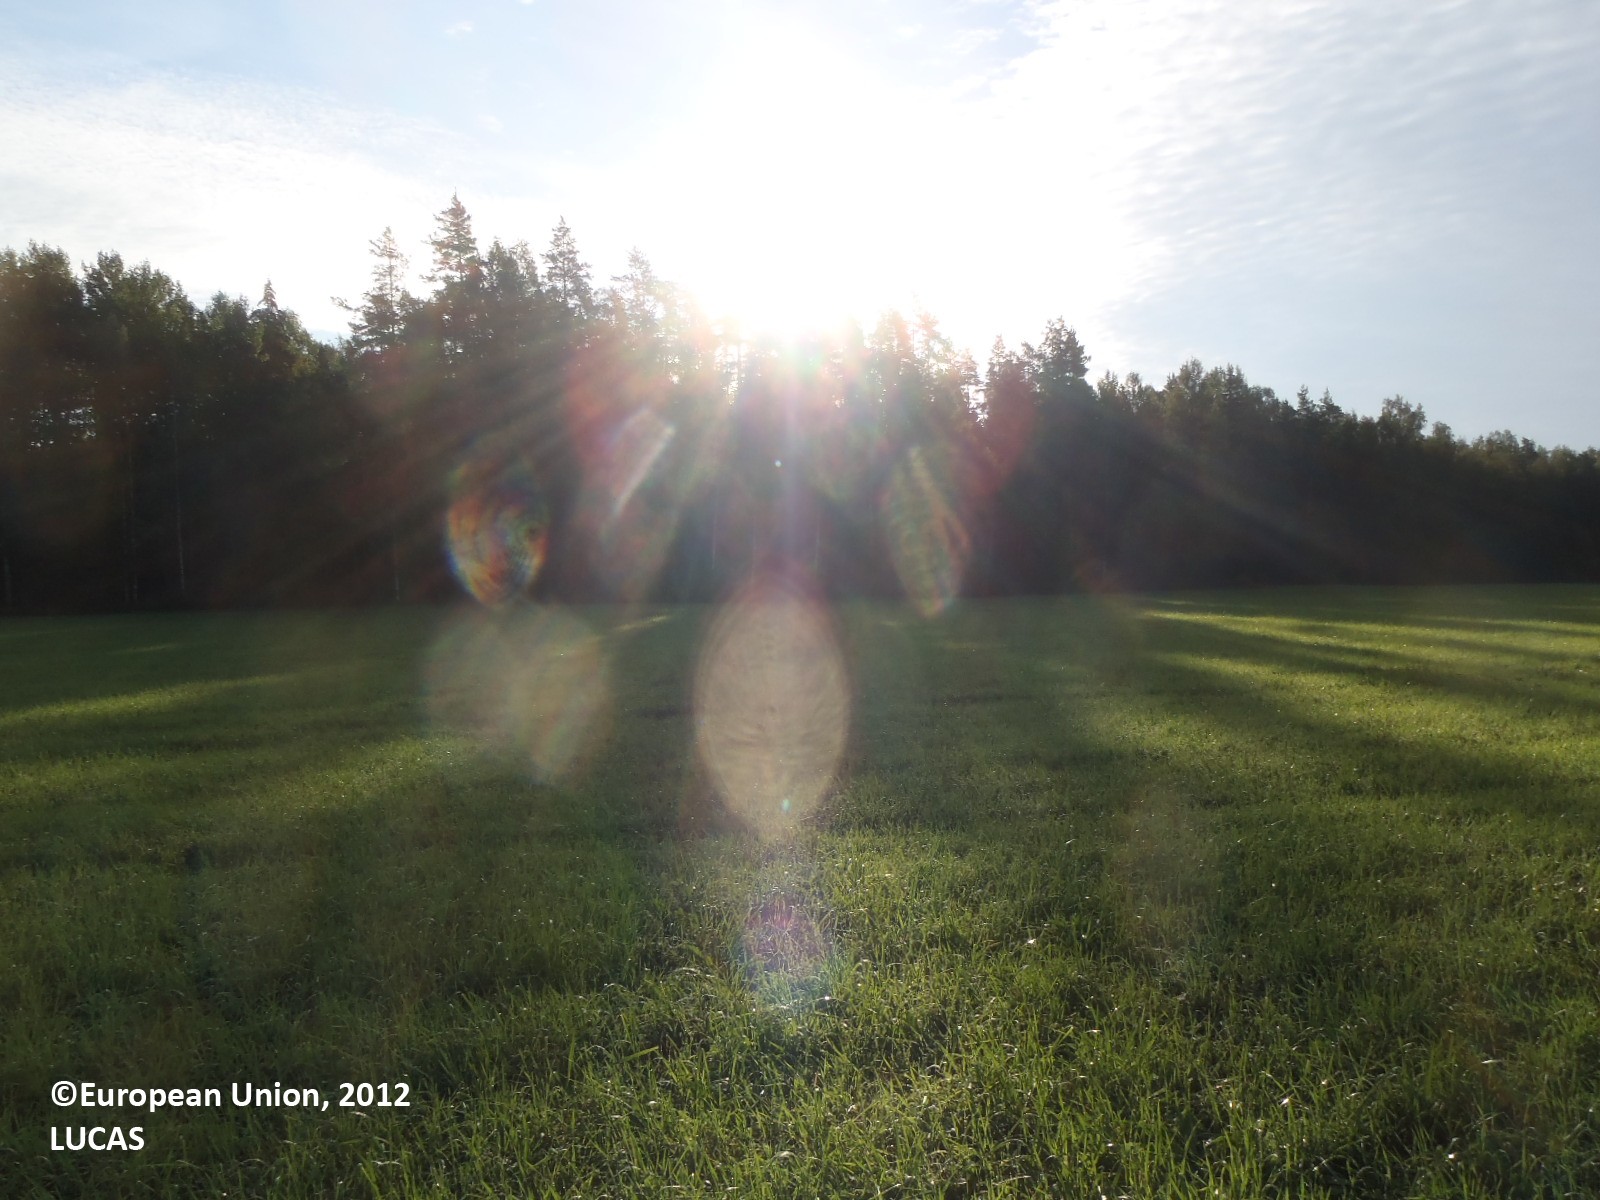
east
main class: Cropland
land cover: Temporary grasslands
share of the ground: > 75 %
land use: Agriculture (excluding fallow land and kitchen gardens)
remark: Harvested field
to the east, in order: Temporary grasslands; Ditches and canals; Pine dominated mixed woodland; Ditches and canals; Spruce dominated mixed woodland; Pine dominated coniferous woodland
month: August
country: FI
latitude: 60.8081
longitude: 22.5117
